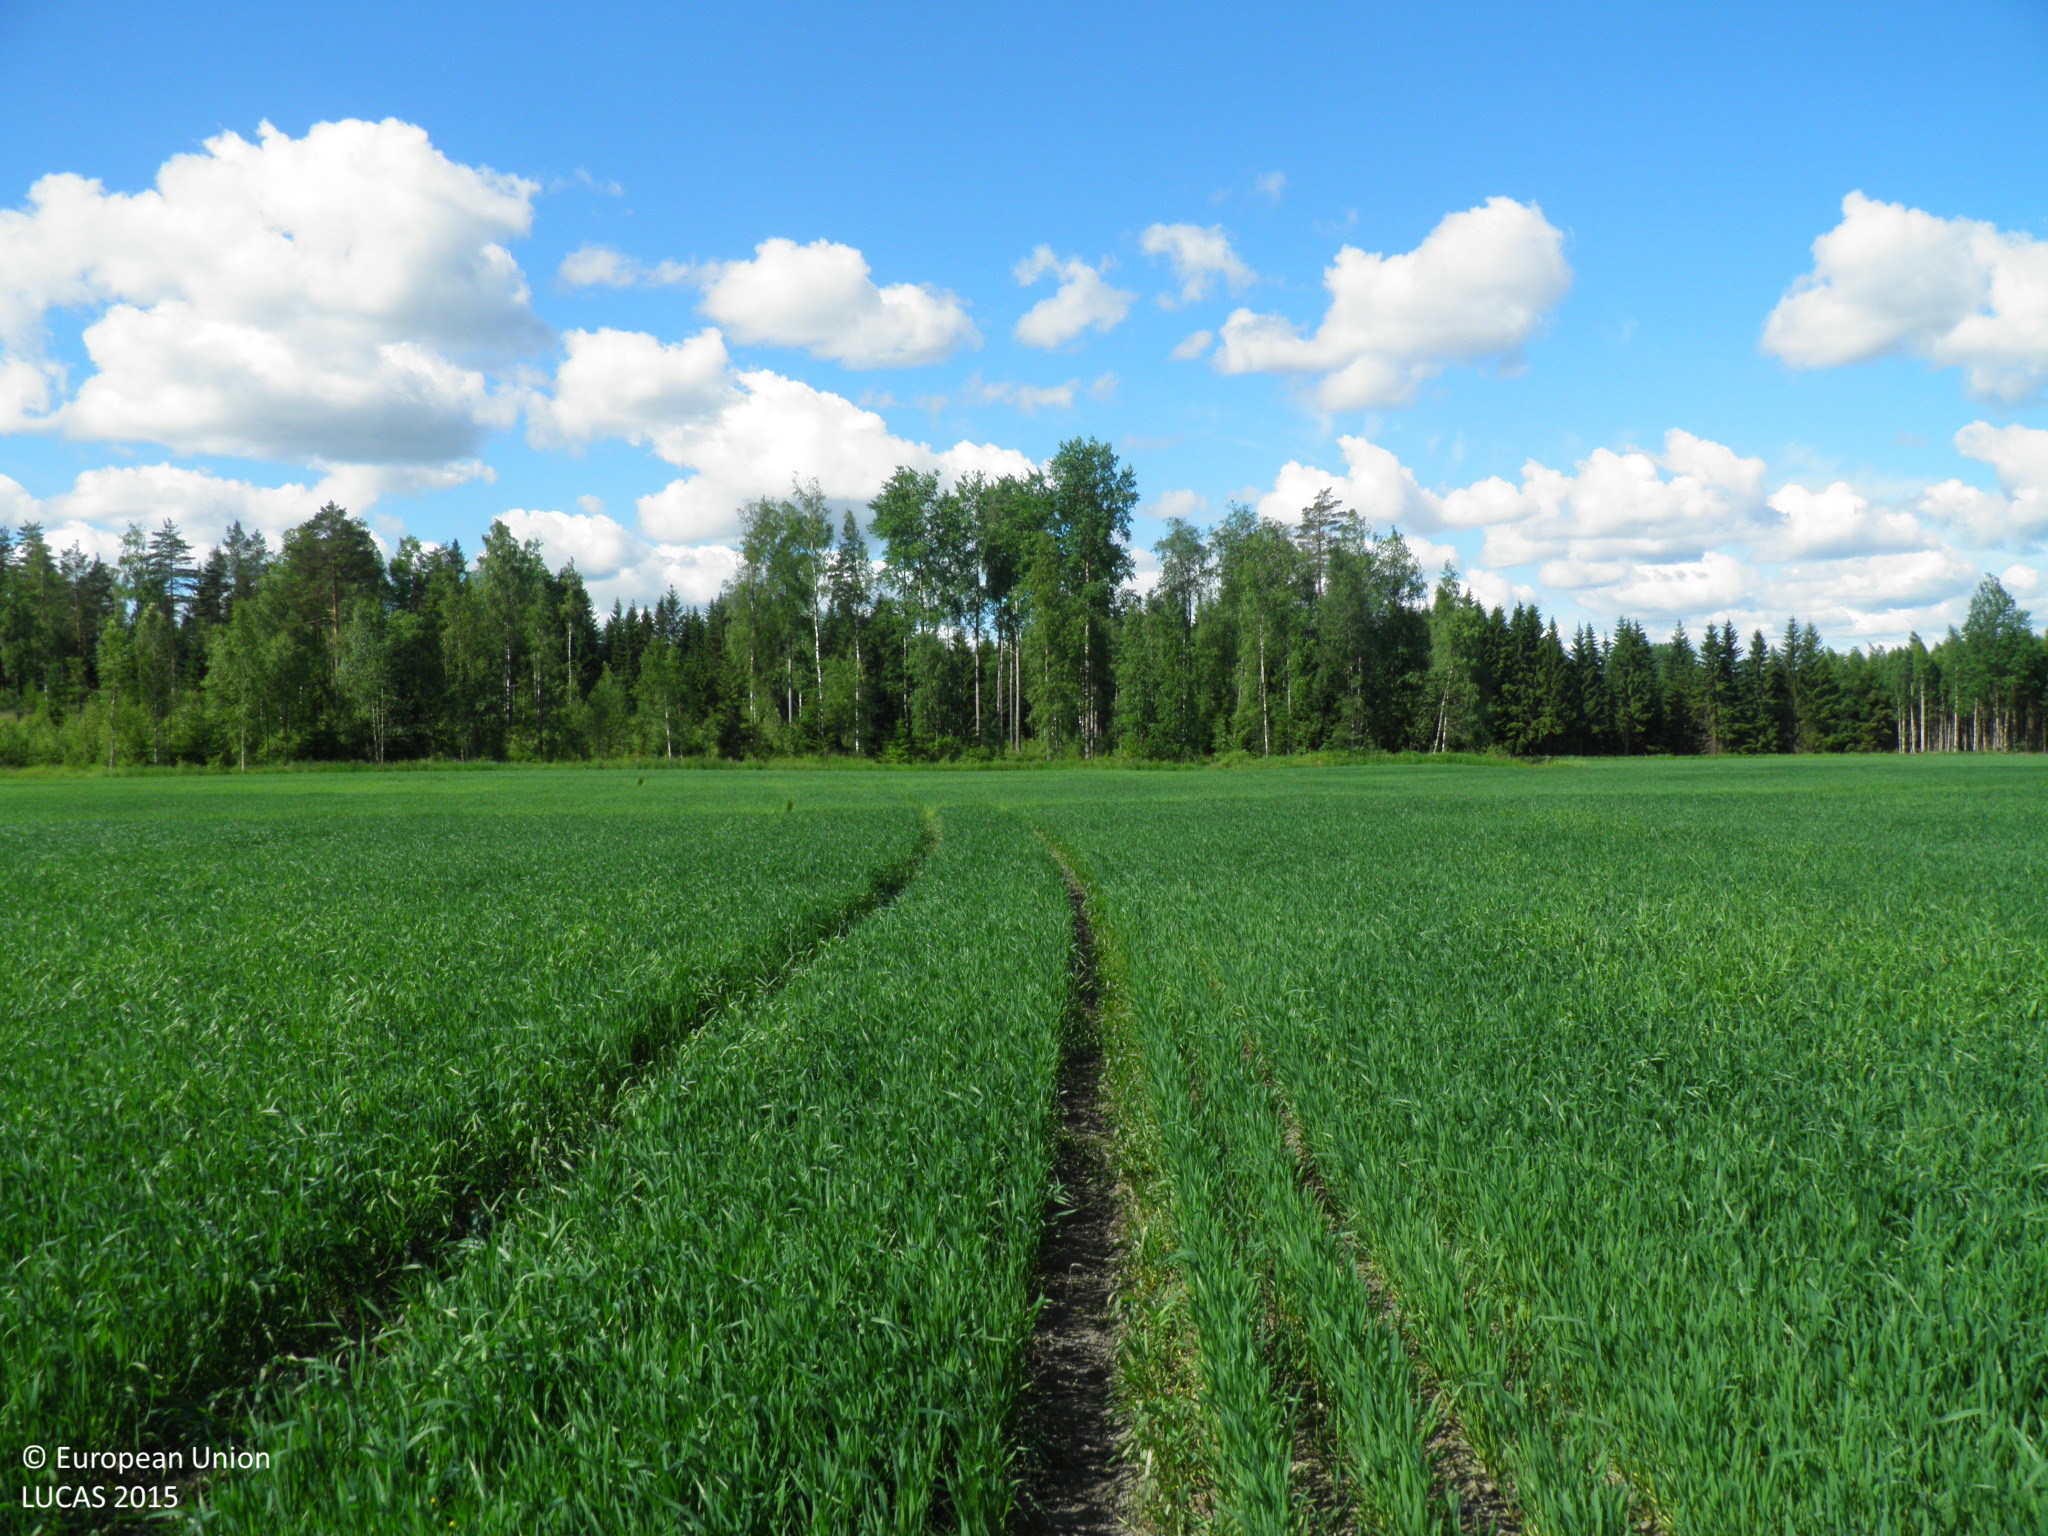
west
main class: Cropland
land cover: Common wheat
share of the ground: > 75 %
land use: Agriculture (excluding fallow land and kitchen gardens)
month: July
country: FI
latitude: 60.5334
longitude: 22.9247
